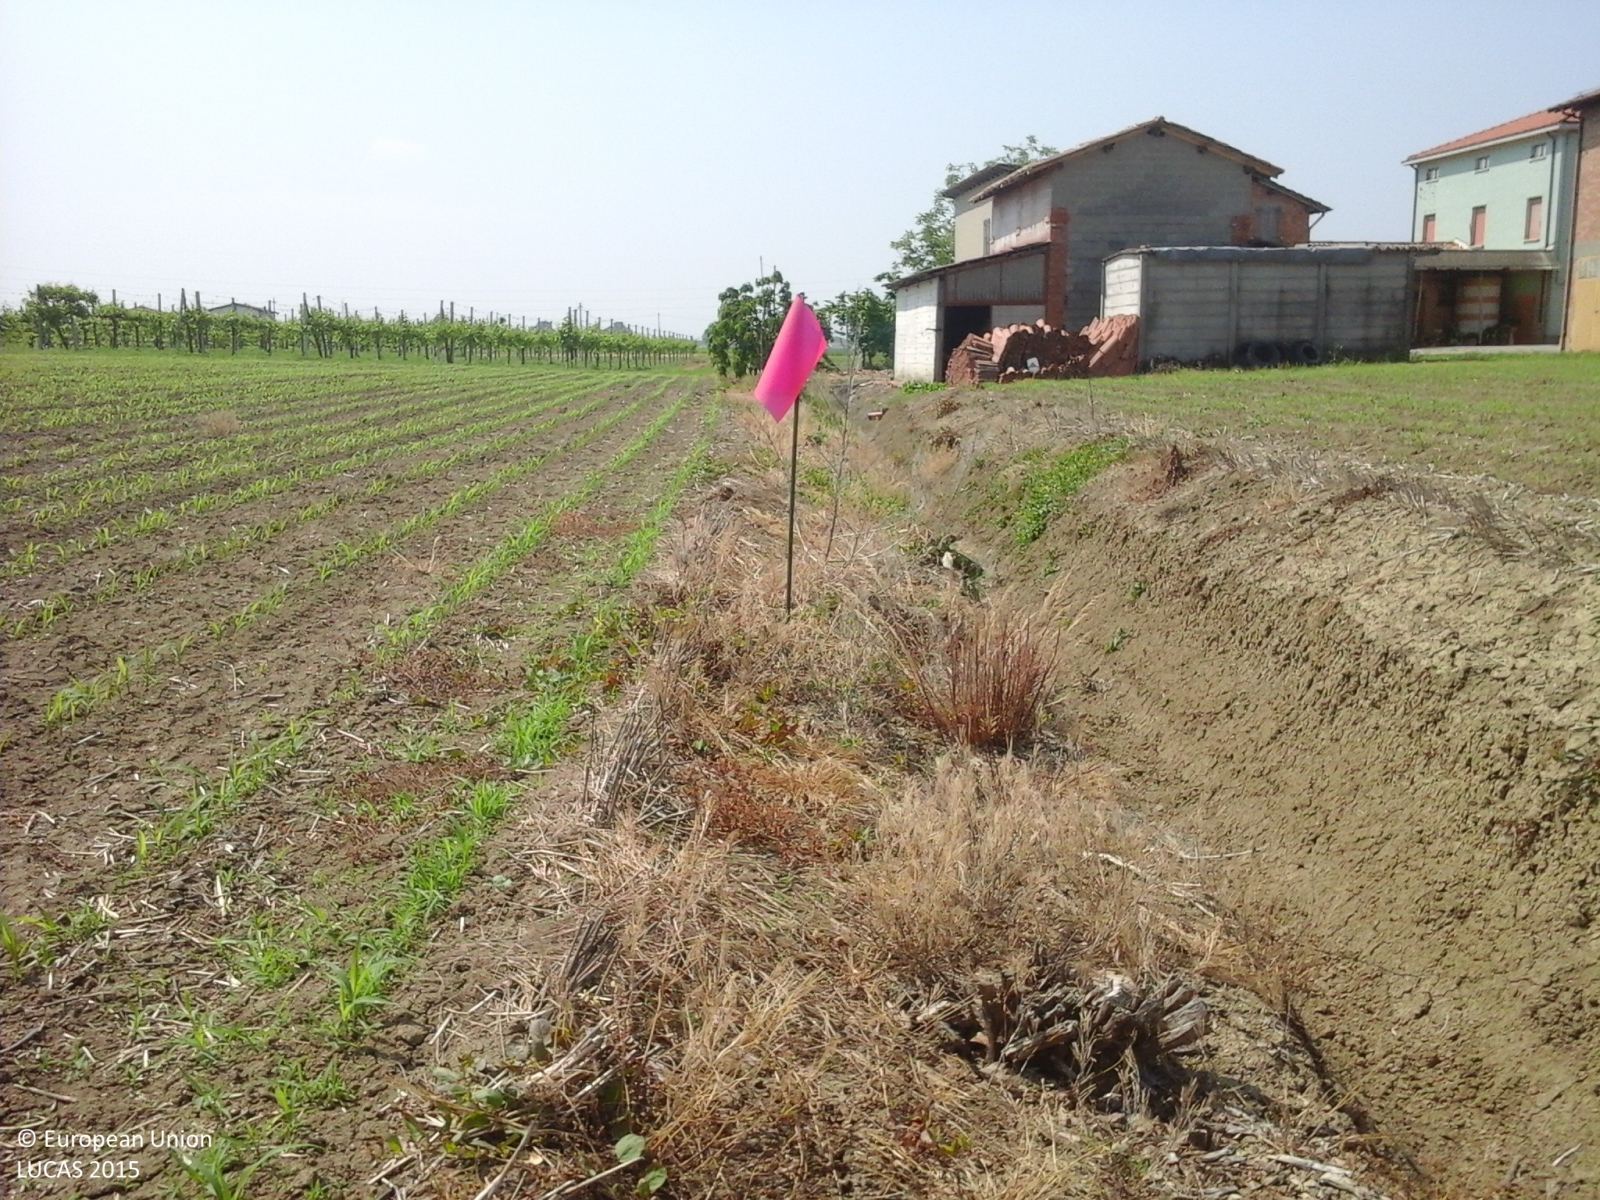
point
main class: Cropland
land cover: Other cereals
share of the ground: < 10 %
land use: Agriculture (excluding fallow land and kitchen gardens)
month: May
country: IT
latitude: 44.5795
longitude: 11.0682
